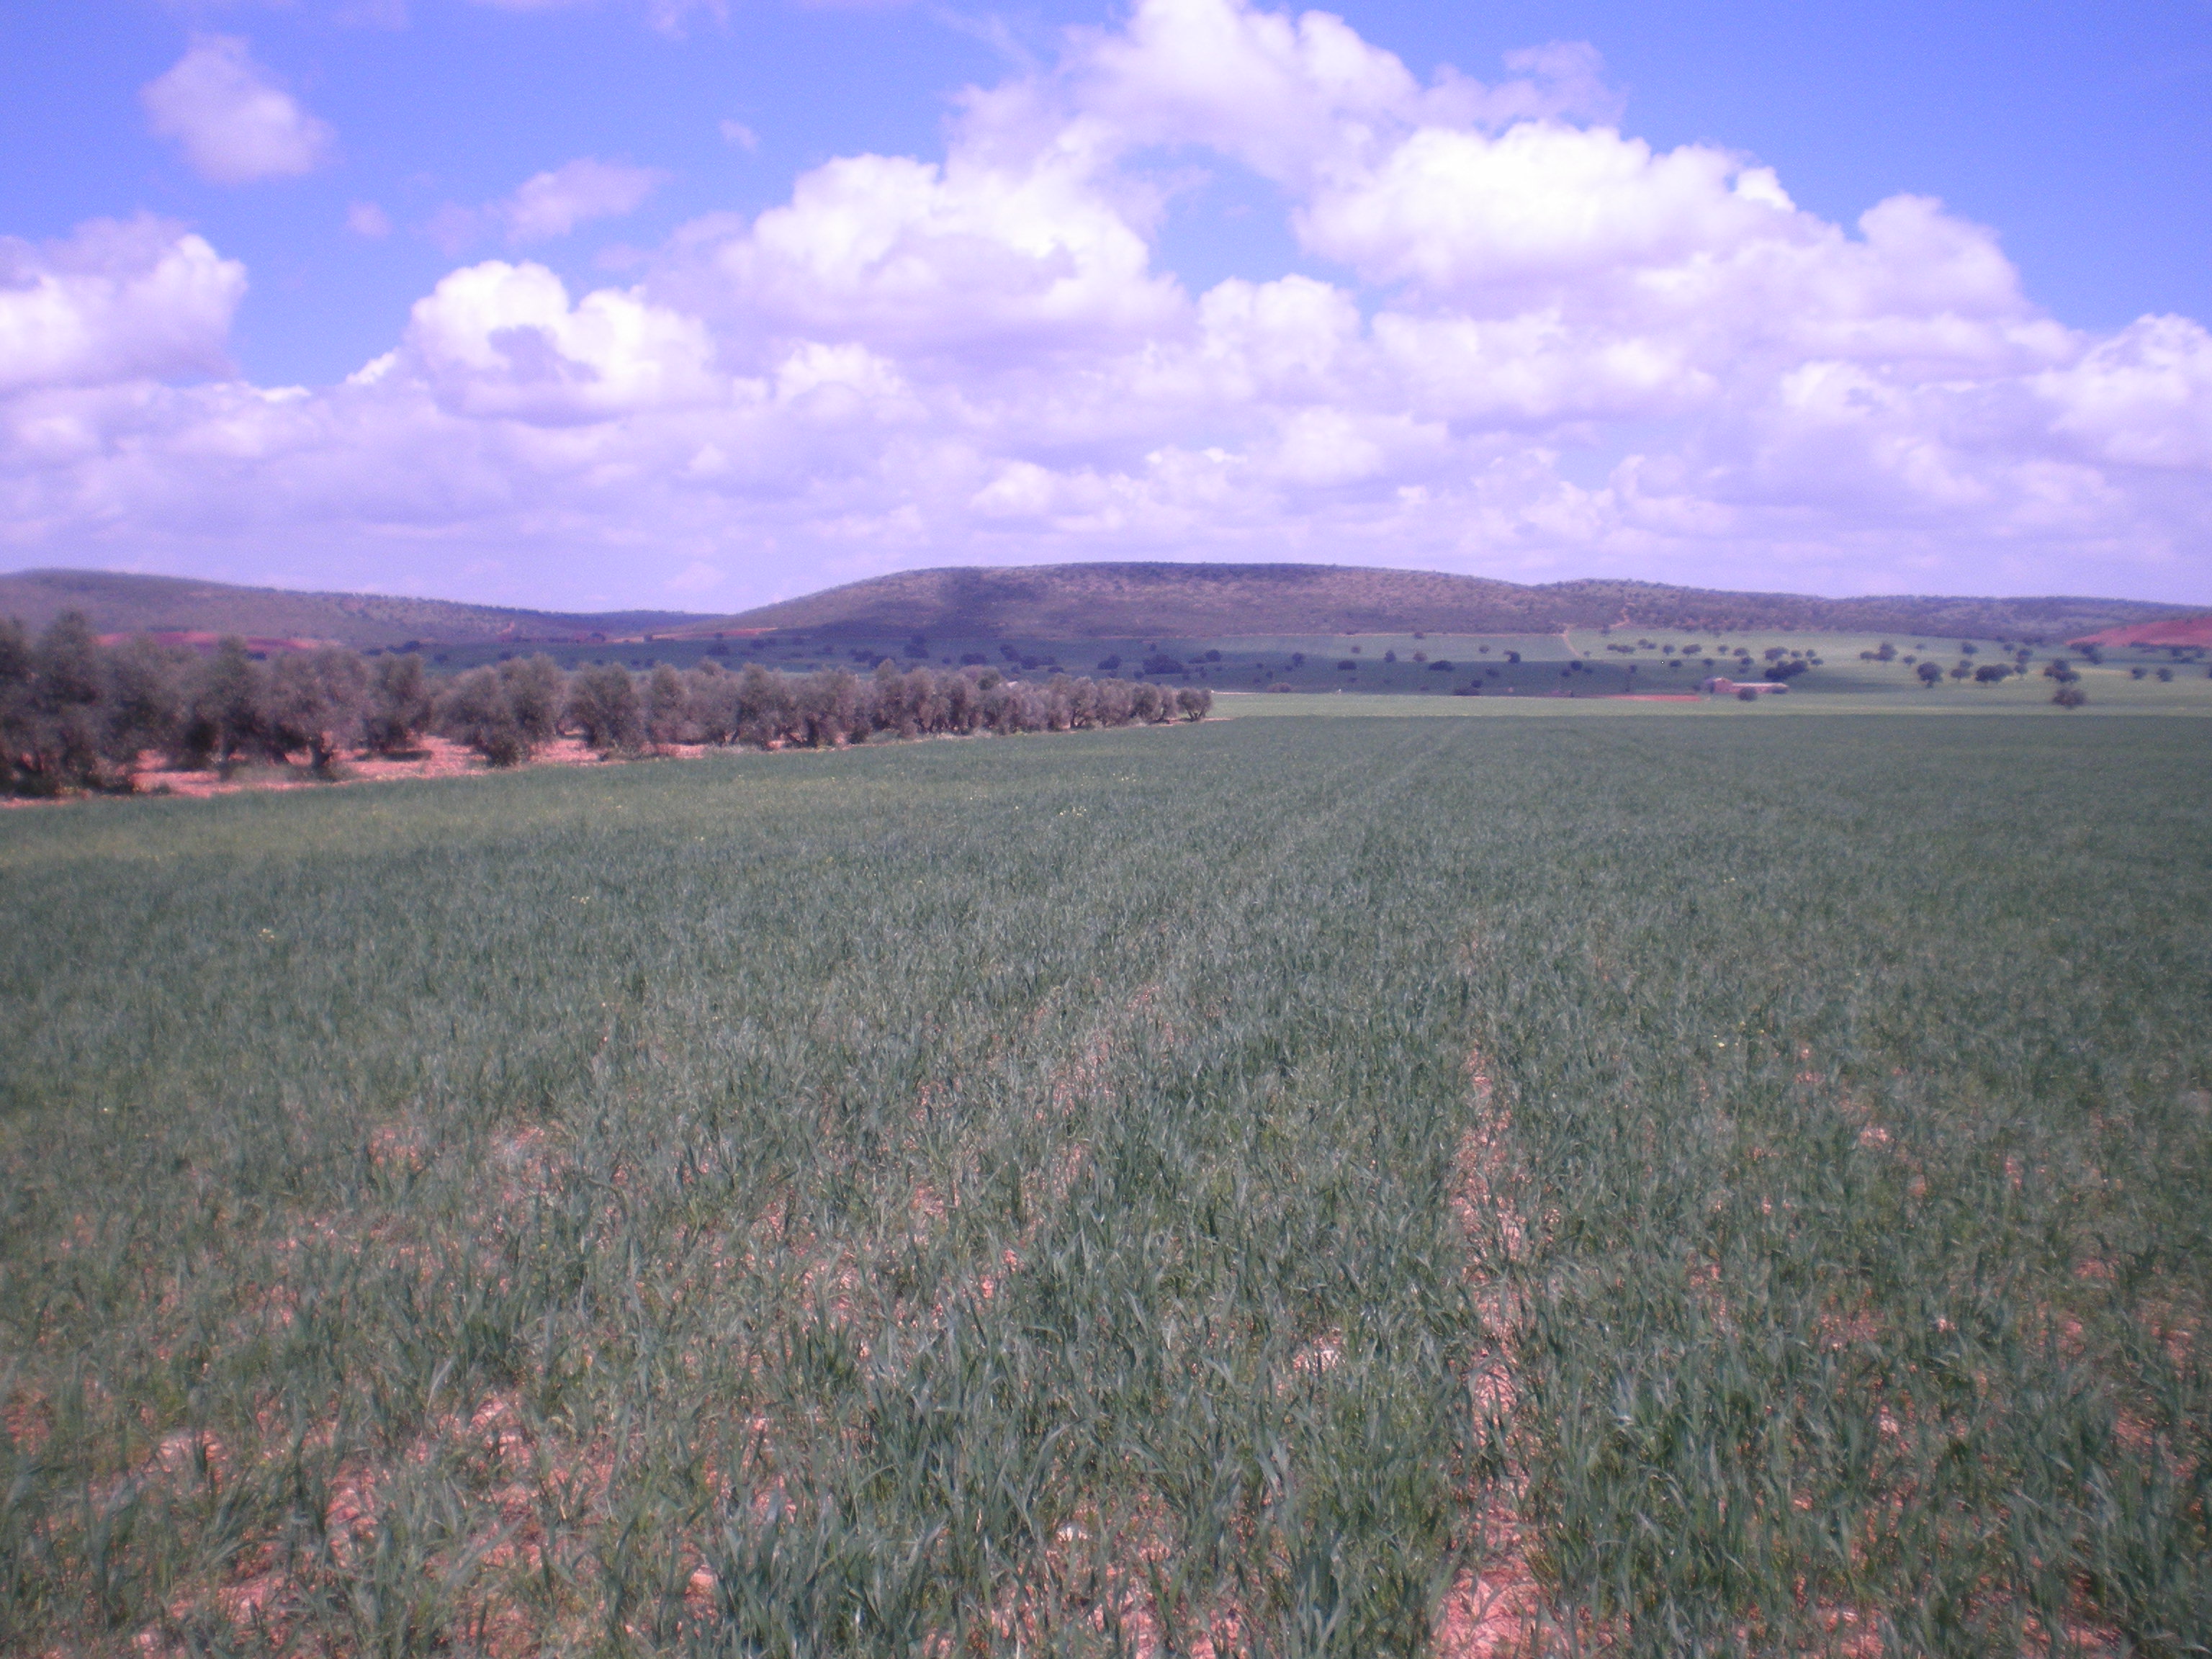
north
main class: Cropland
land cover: Barley
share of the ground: 50 - 75 %
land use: Agriculture (excluding fallow land and kitchen gardens)
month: April
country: ES
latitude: 38.6887
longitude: -3.4965
